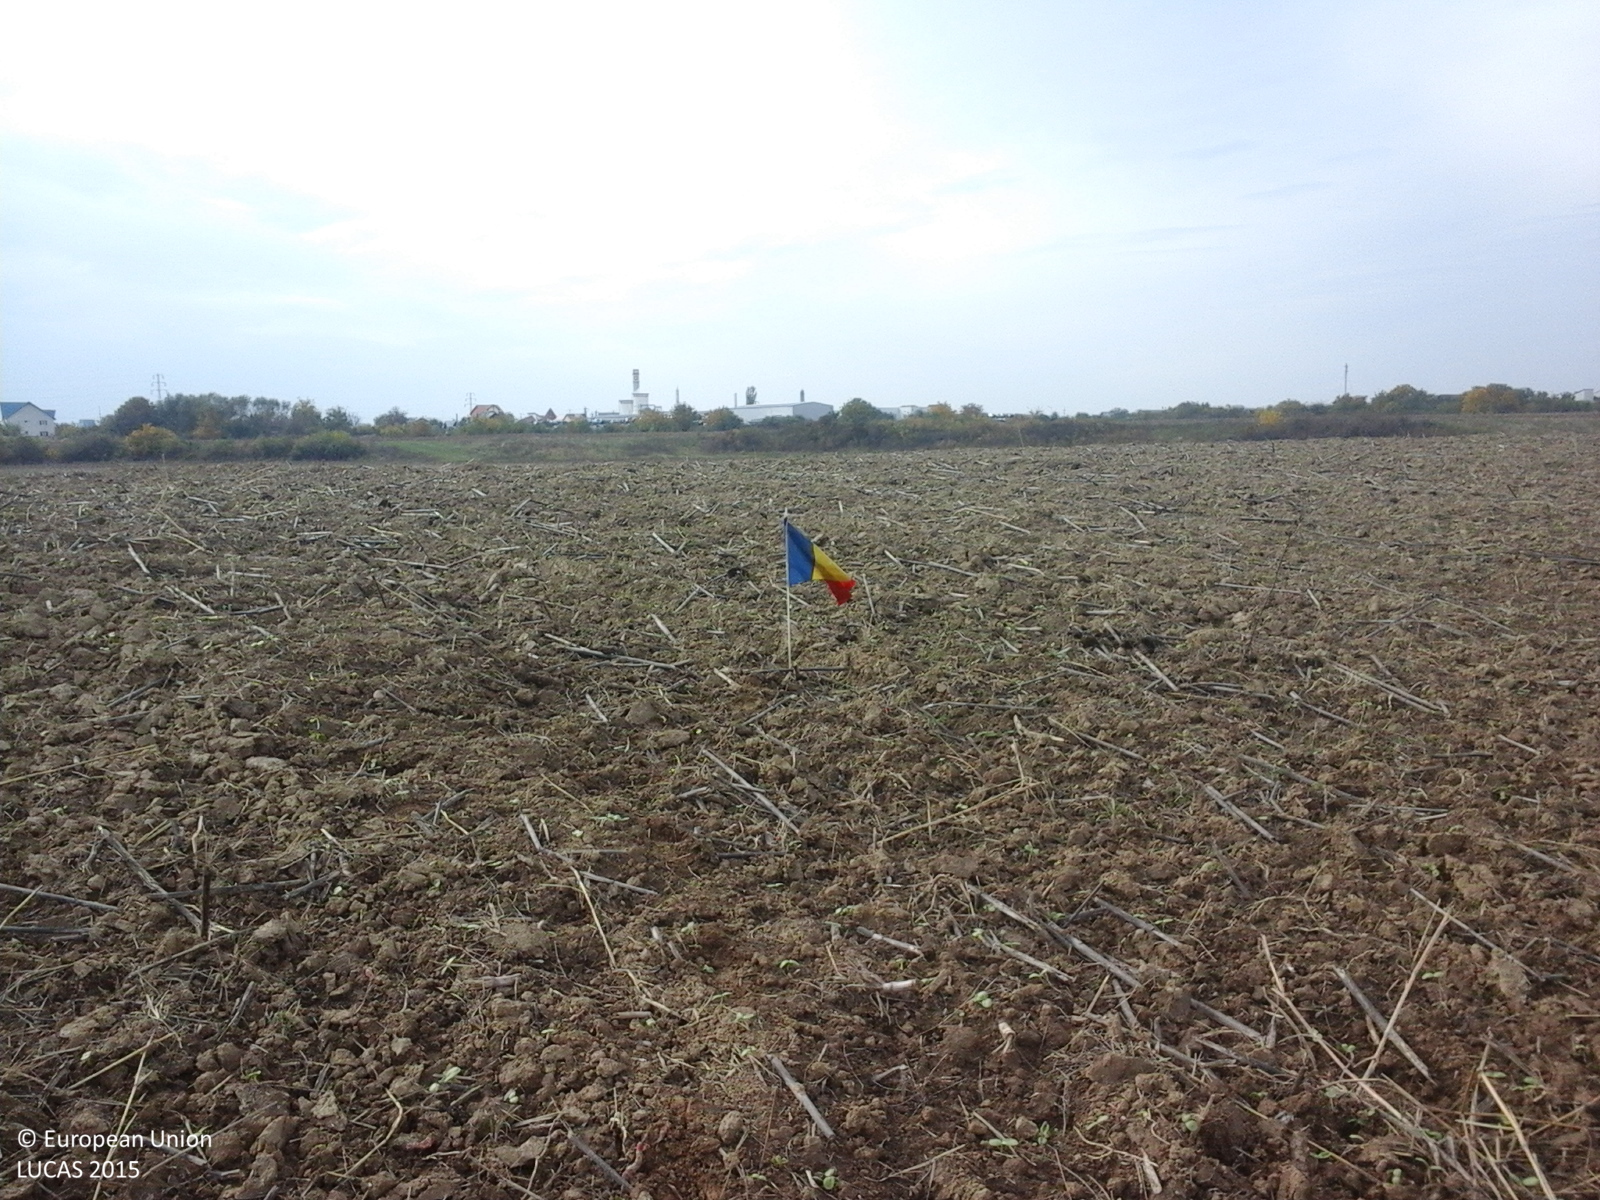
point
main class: Cropland
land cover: Sunflower
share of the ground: 10 - 25 %
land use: Agriculture (excluding fallow land and kitchen gardens)
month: October
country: RO
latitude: 44.9647
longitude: 26.0453
